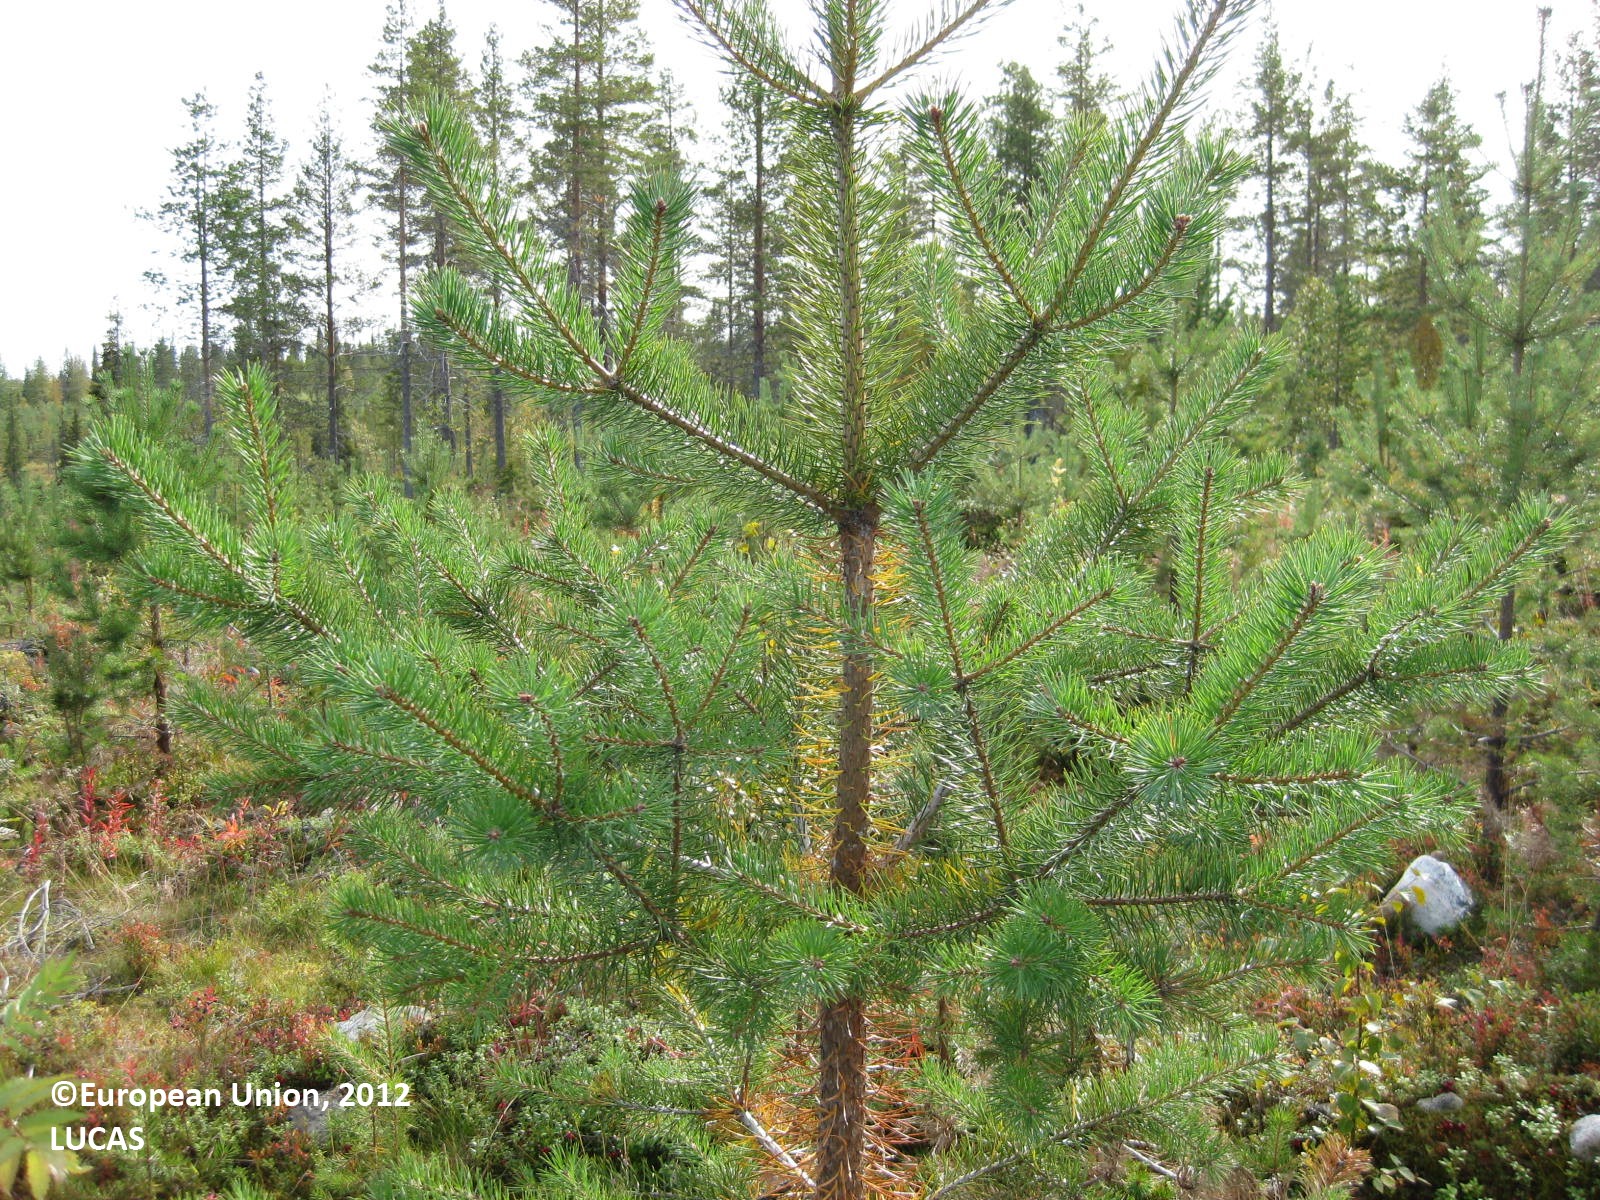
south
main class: Woodland
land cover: Pine dominated coniferous woodland
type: boreal forest
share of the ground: 50 - 75 %
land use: Forestry
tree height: < 5 m
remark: Clear cut
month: August
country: FI
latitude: 65.8890
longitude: 28.7002
